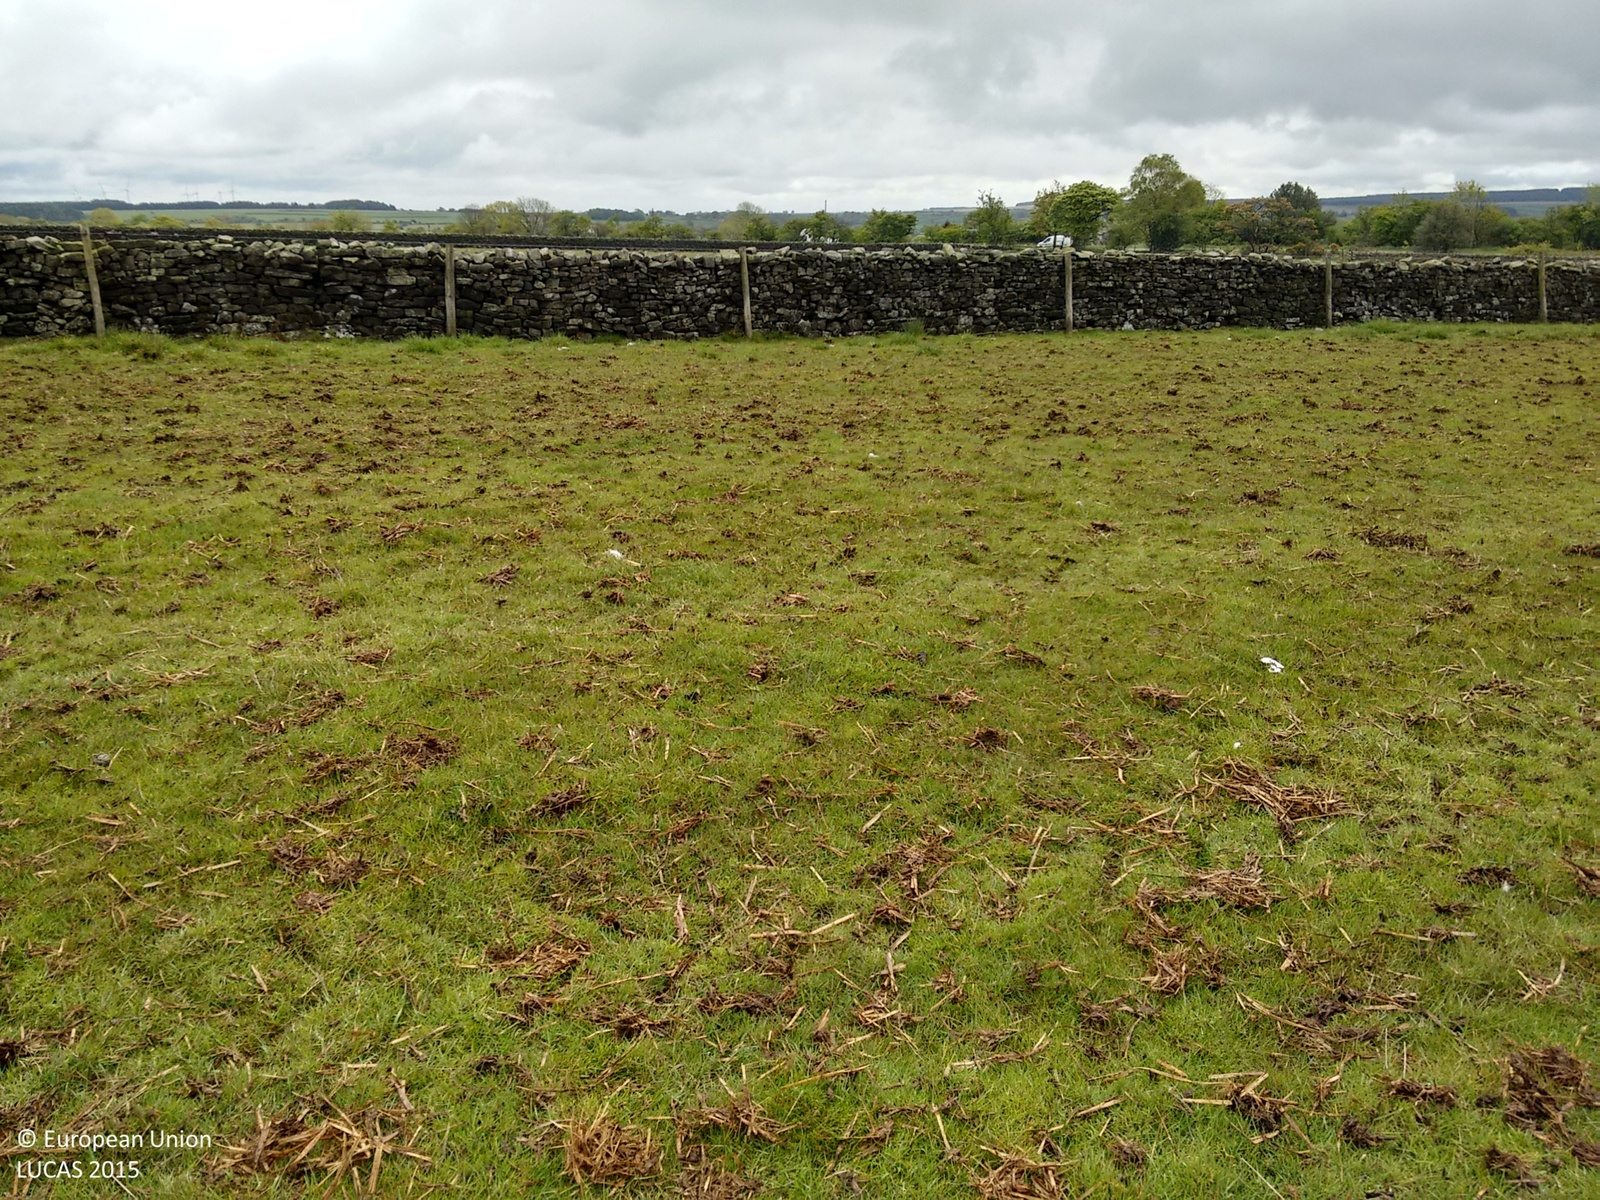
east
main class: Grassland
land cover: Grassland without tree/shrub cover
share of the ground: > 75 %
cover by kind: herbaceous plants 100 %
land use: Agriculture (excluding fallow land and kitchen gardens)
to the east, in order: Grassland without tree/shrub cover; Fences; Dry stone walls; Grassland without tree/shrub cover; Dry stone walls; Grassland without tree/shrub cover
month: May
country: GB
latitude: 53.9937
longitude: -1.7214
